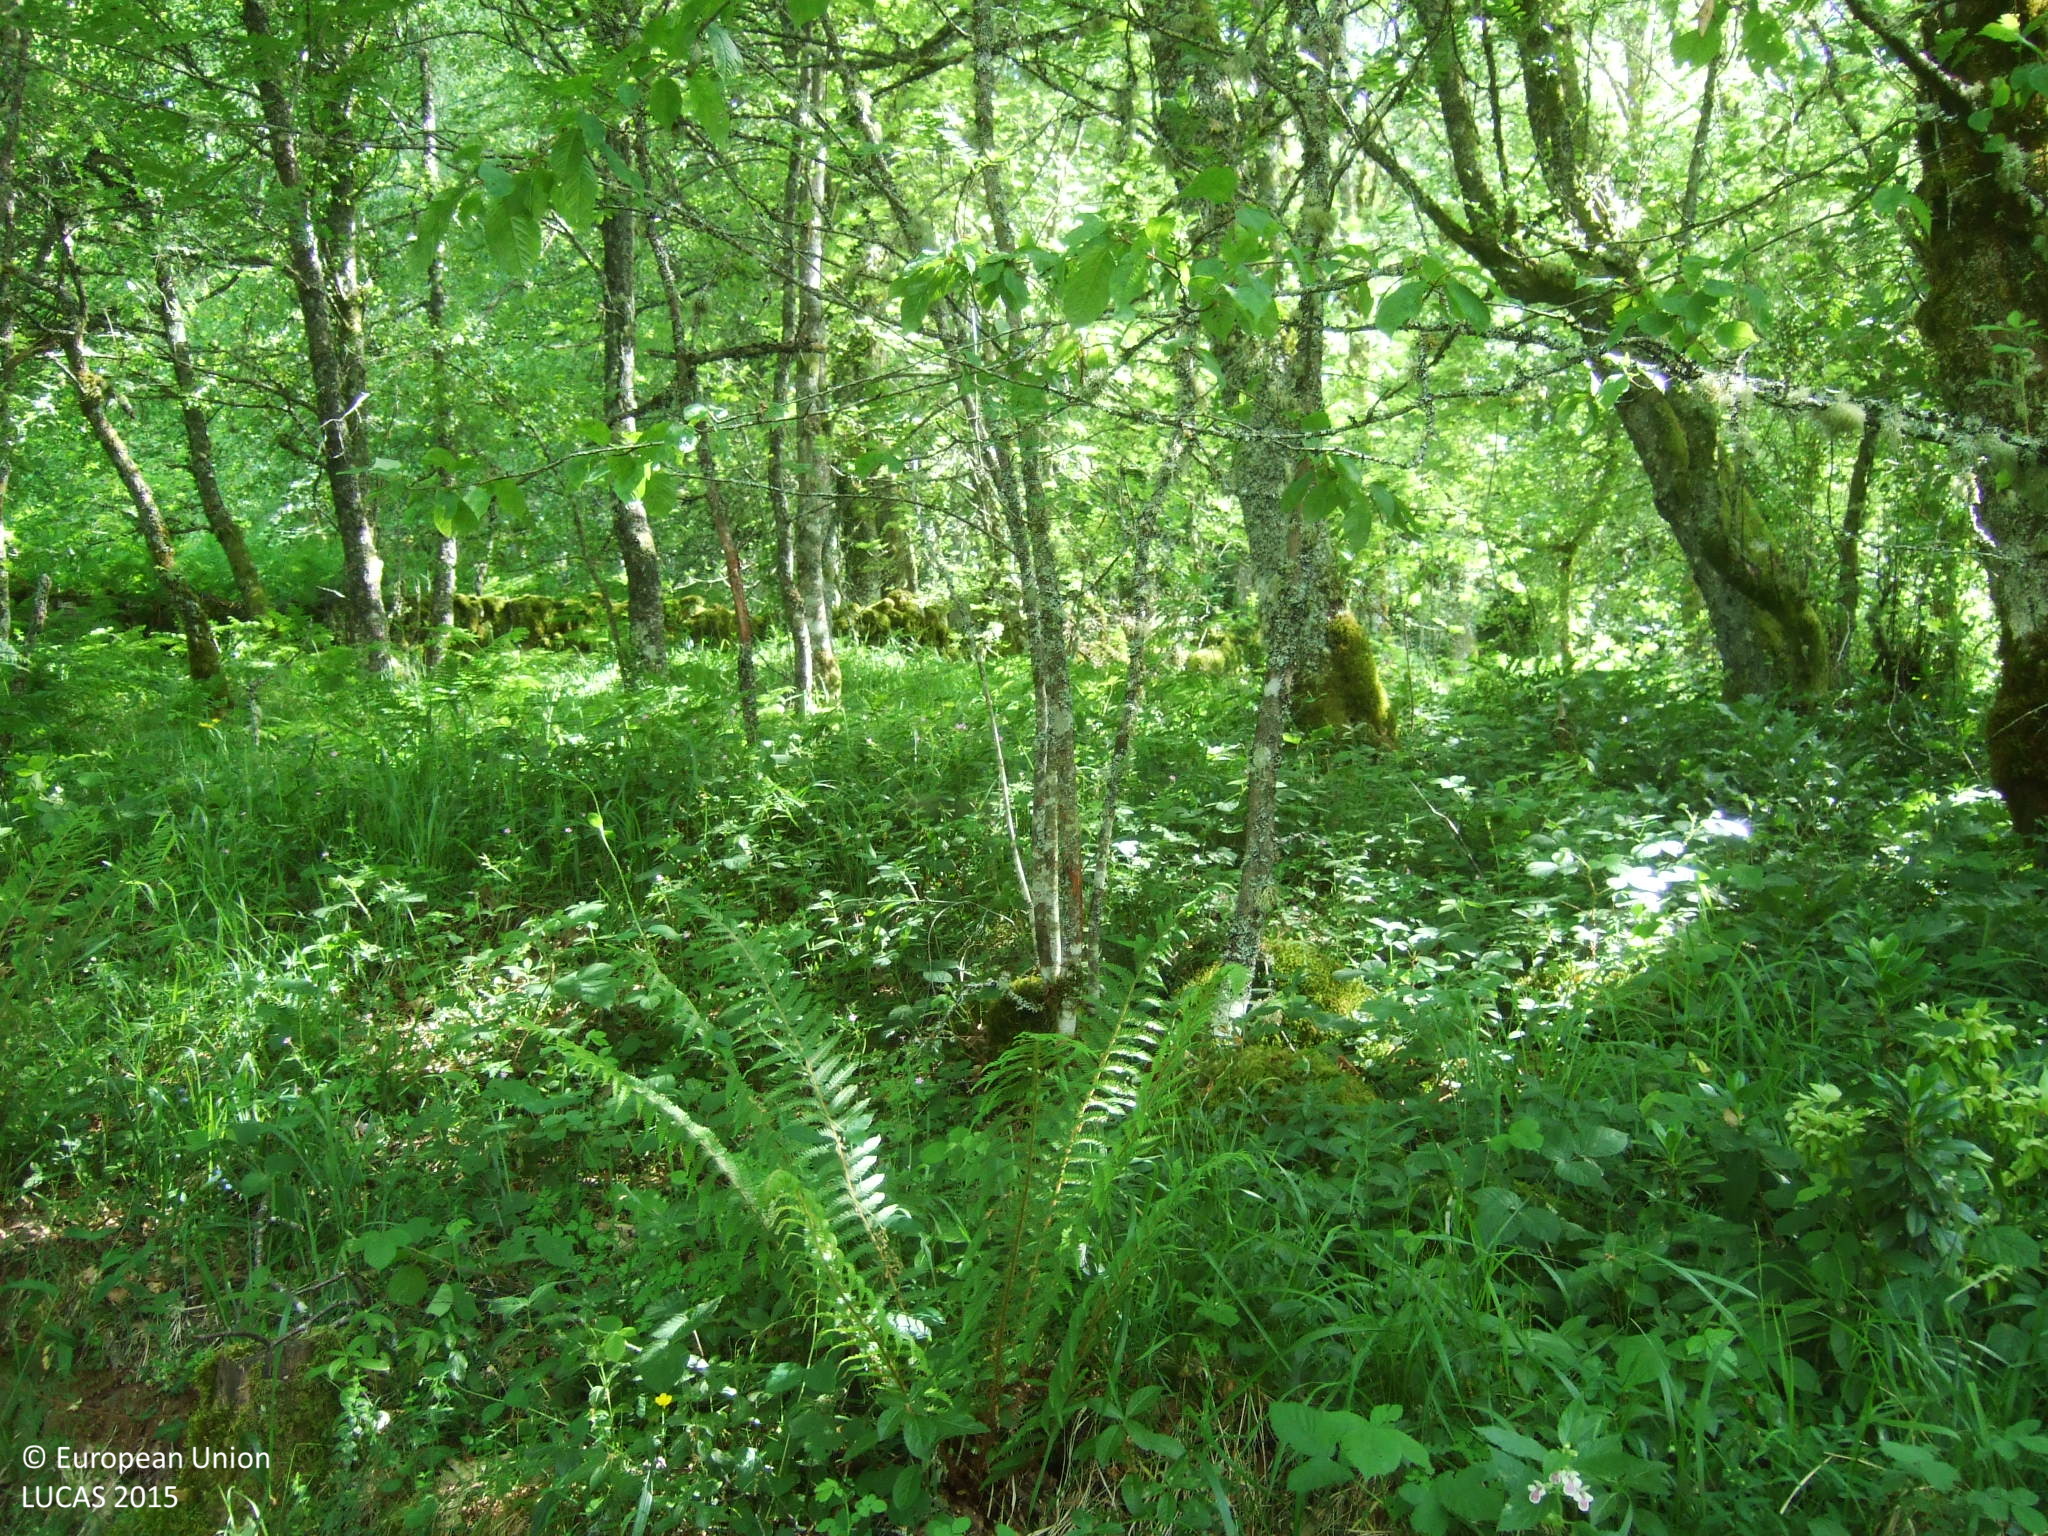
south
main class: Woodland
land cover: Broadleaved woodland
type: acidophilous oak and oak-birch forest
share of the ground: > 75 %
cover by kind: broadleaved forest trees 80 %, shrubs 20 %
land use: Semi-natural and natural areas not in use
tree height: > 5 m
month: June
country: ES
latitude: 42.6855
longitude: -7.0610
